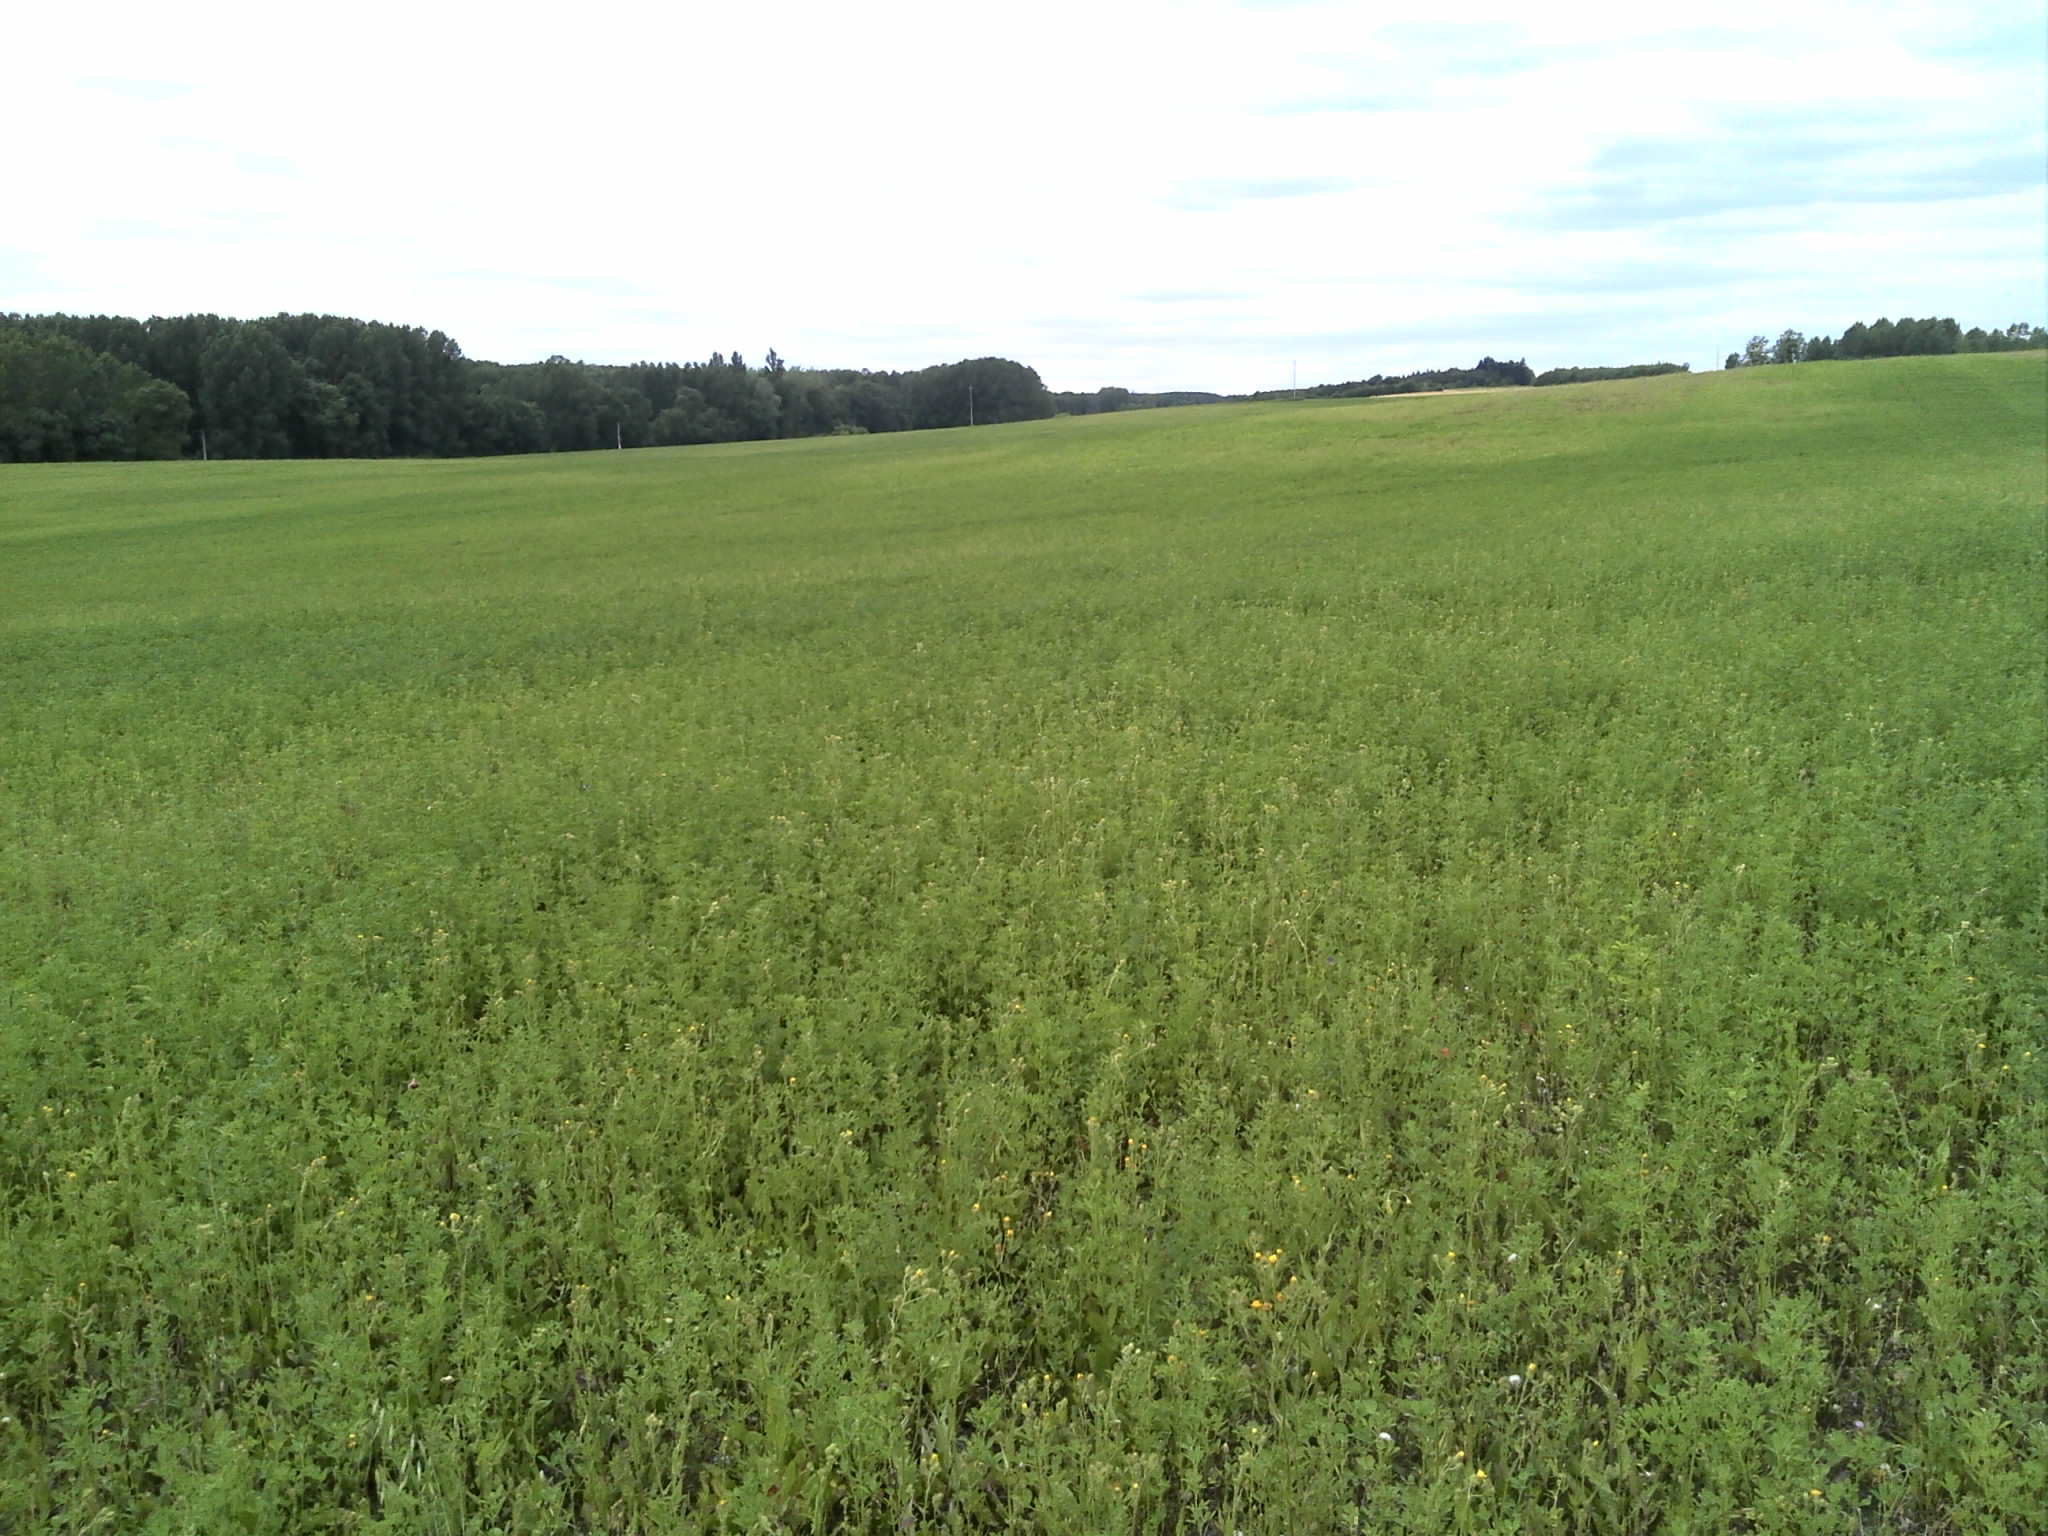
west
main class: Cropland
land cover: Lucerne
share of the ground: > 75 %
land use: Agriculture (excluding fallow land and kitchen gardens)
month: June
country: FR
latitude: 47.2489
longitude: 1.5711
